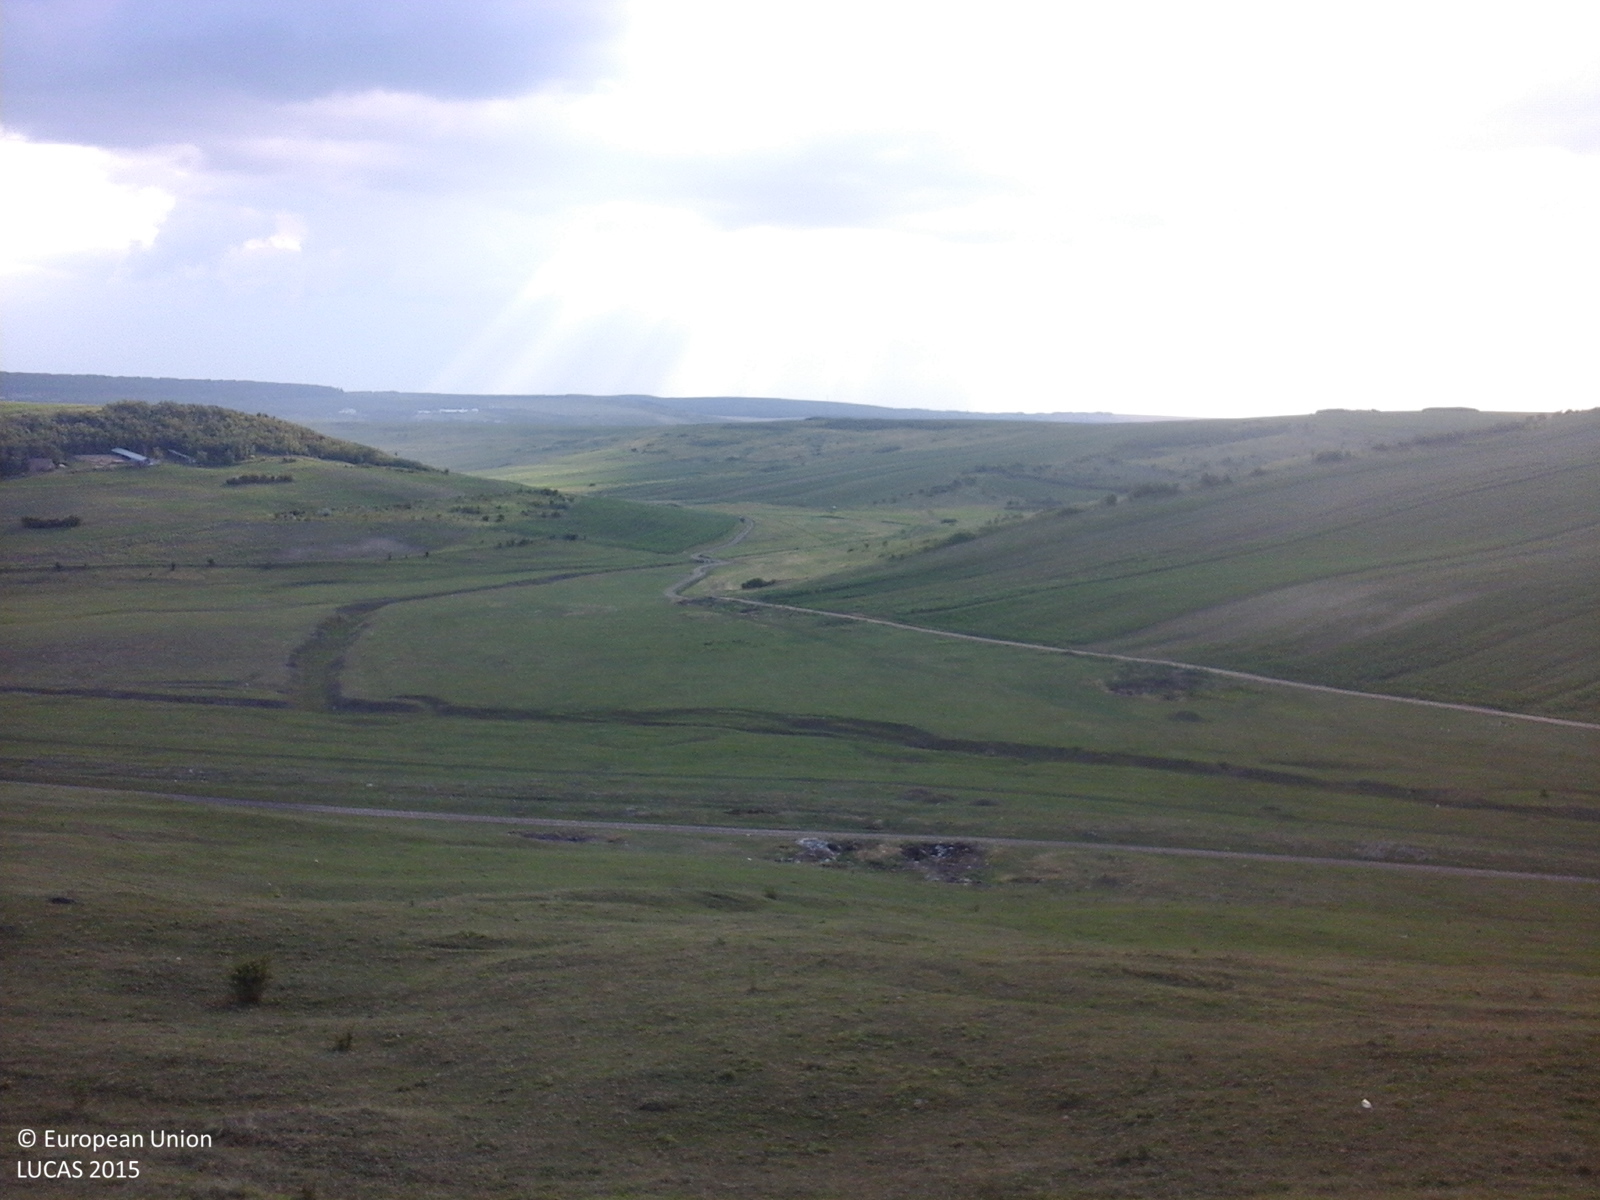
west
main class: Grassland
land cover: Grassland with sparse tree/shrub cover
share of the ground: > 75 %
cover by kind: herbaceous plants 85 %, shrubs 10 %, broadleaved forest trees 5 %
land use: Agriculture (excluding fallow land and kitchen gardens)
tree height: < 5 m
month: June
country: RO
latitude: 47.1834
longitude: 27.0055
